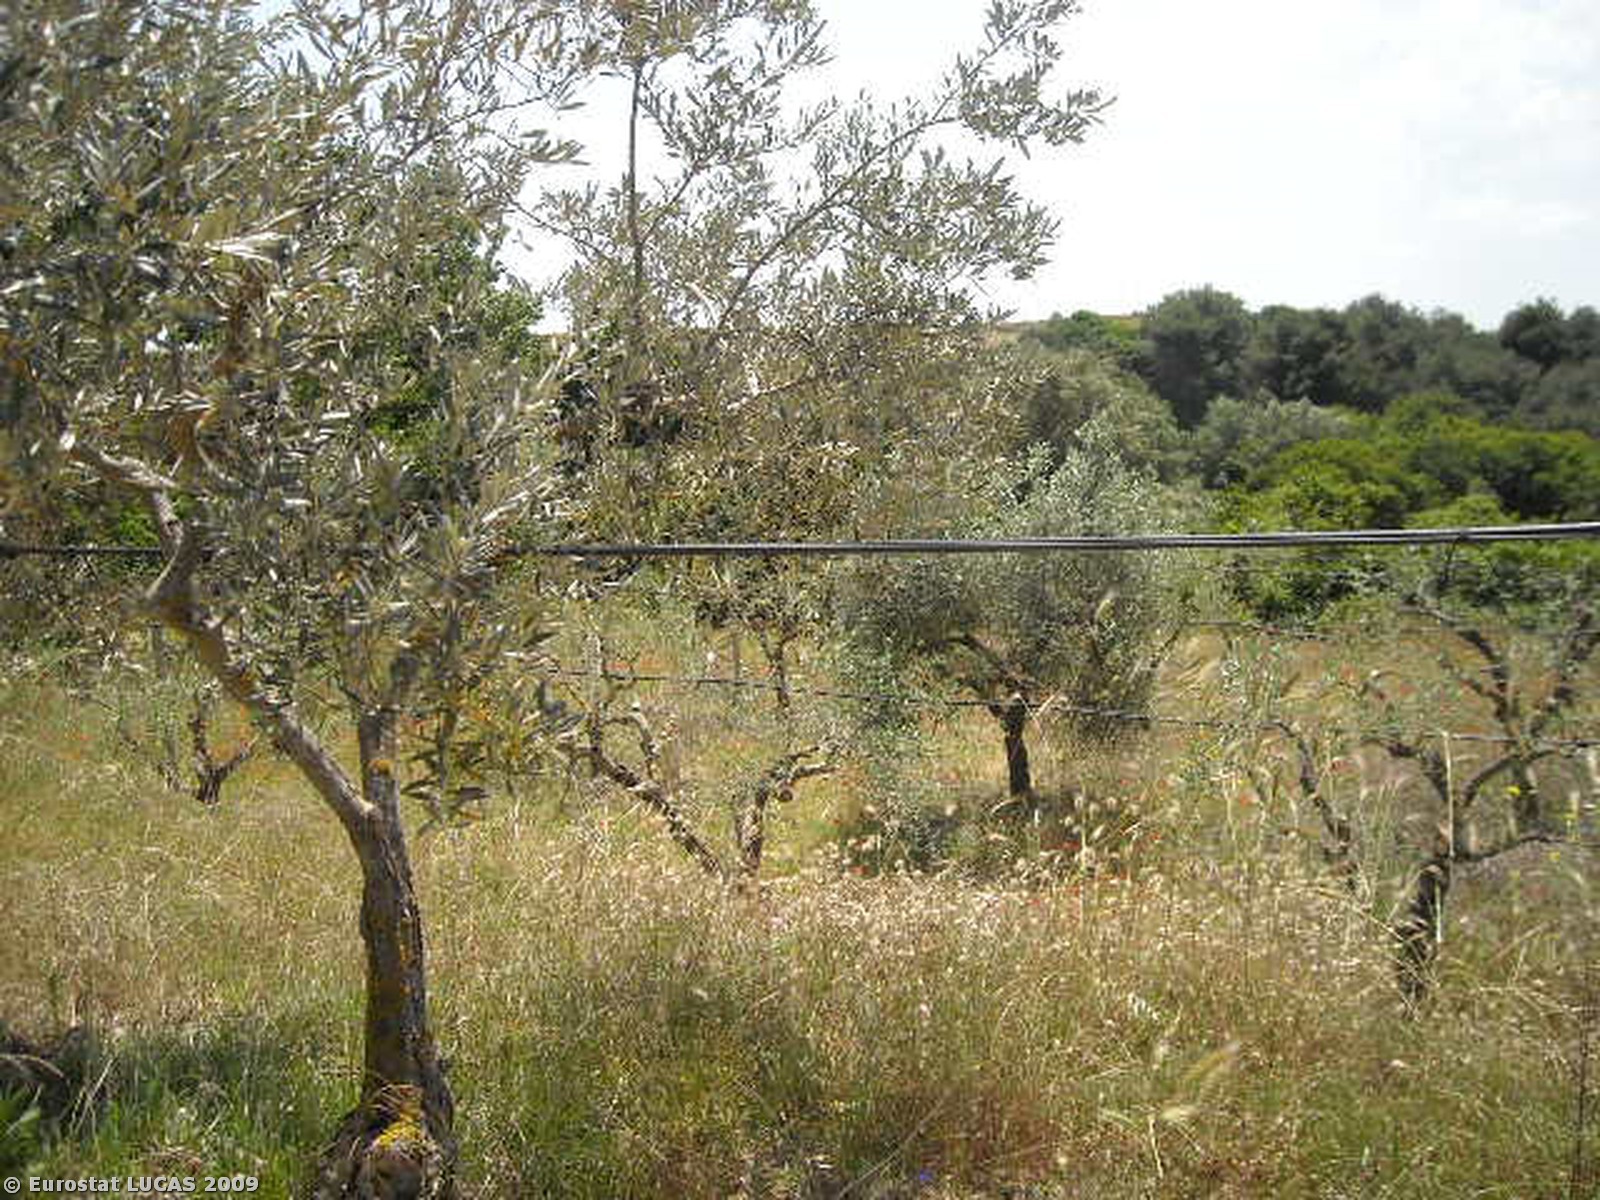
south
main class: Cropland
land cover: Vineyards
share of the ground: 25 - 50 %
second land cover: Bare land
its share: > 75 %
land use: Agriculture (excluding fallow land and kitchen gardens)
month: May
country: IT
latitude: 40.5305
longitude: 16.9291
